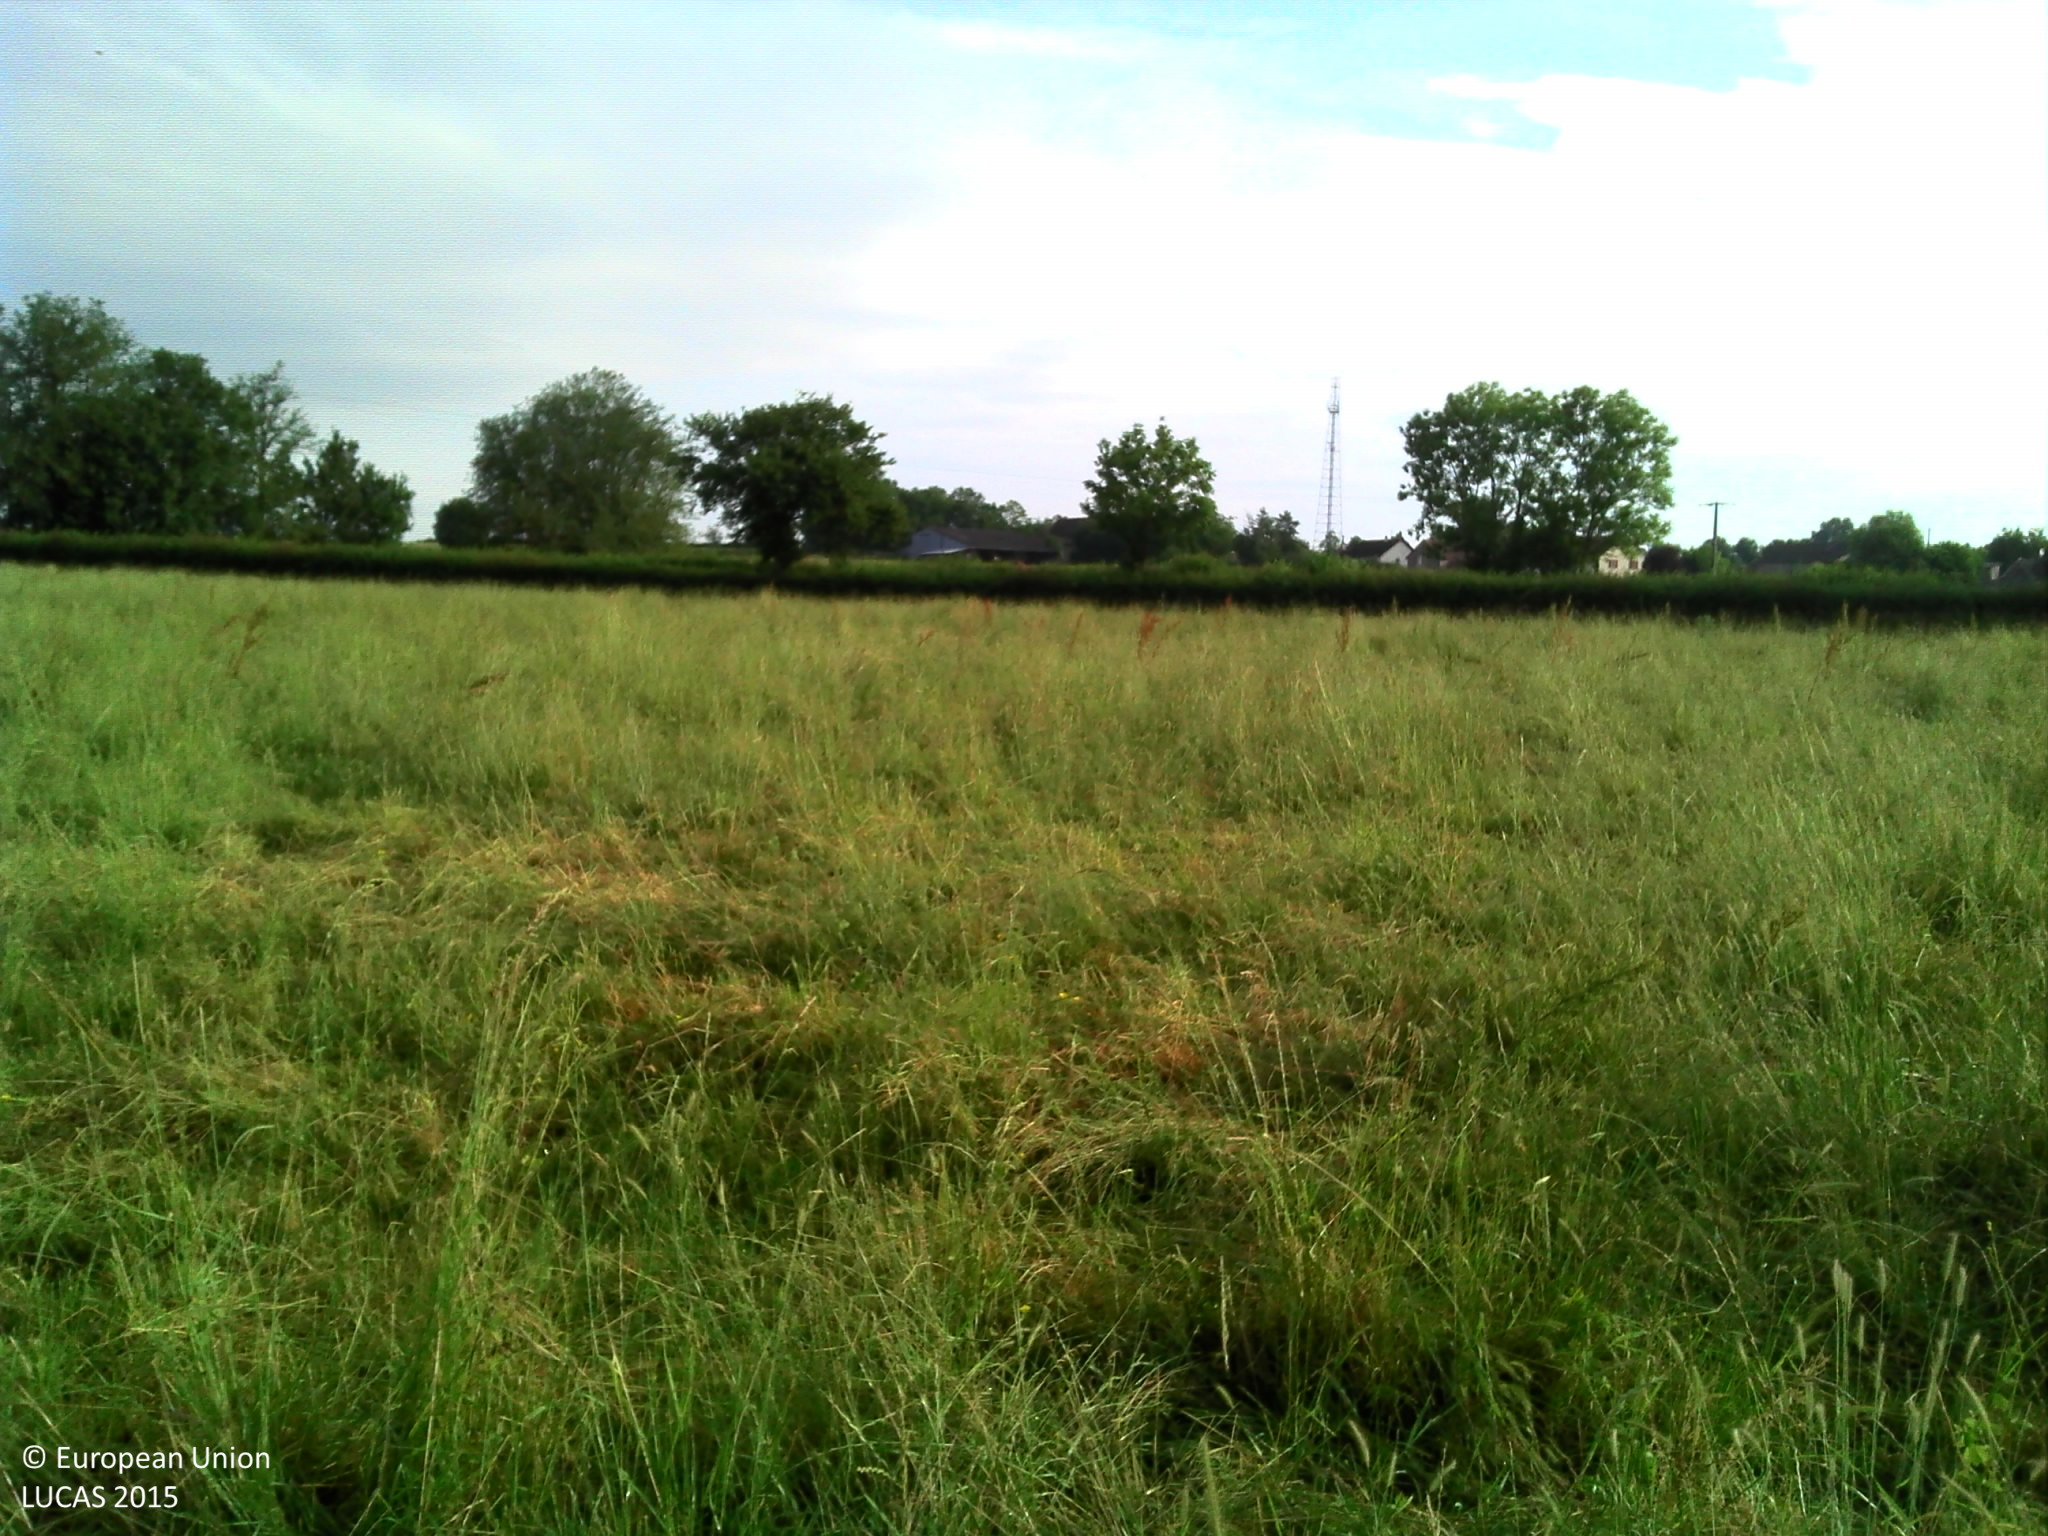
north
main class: Grassland
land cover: Grassland without tree/shrub cover
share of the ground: > 75 %
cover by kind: herbaceous plants 100 %
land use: Agriculture (excluding fallow land and kitchen gardens)
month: June
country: FR
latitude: 46.7151
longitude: 2.6824
